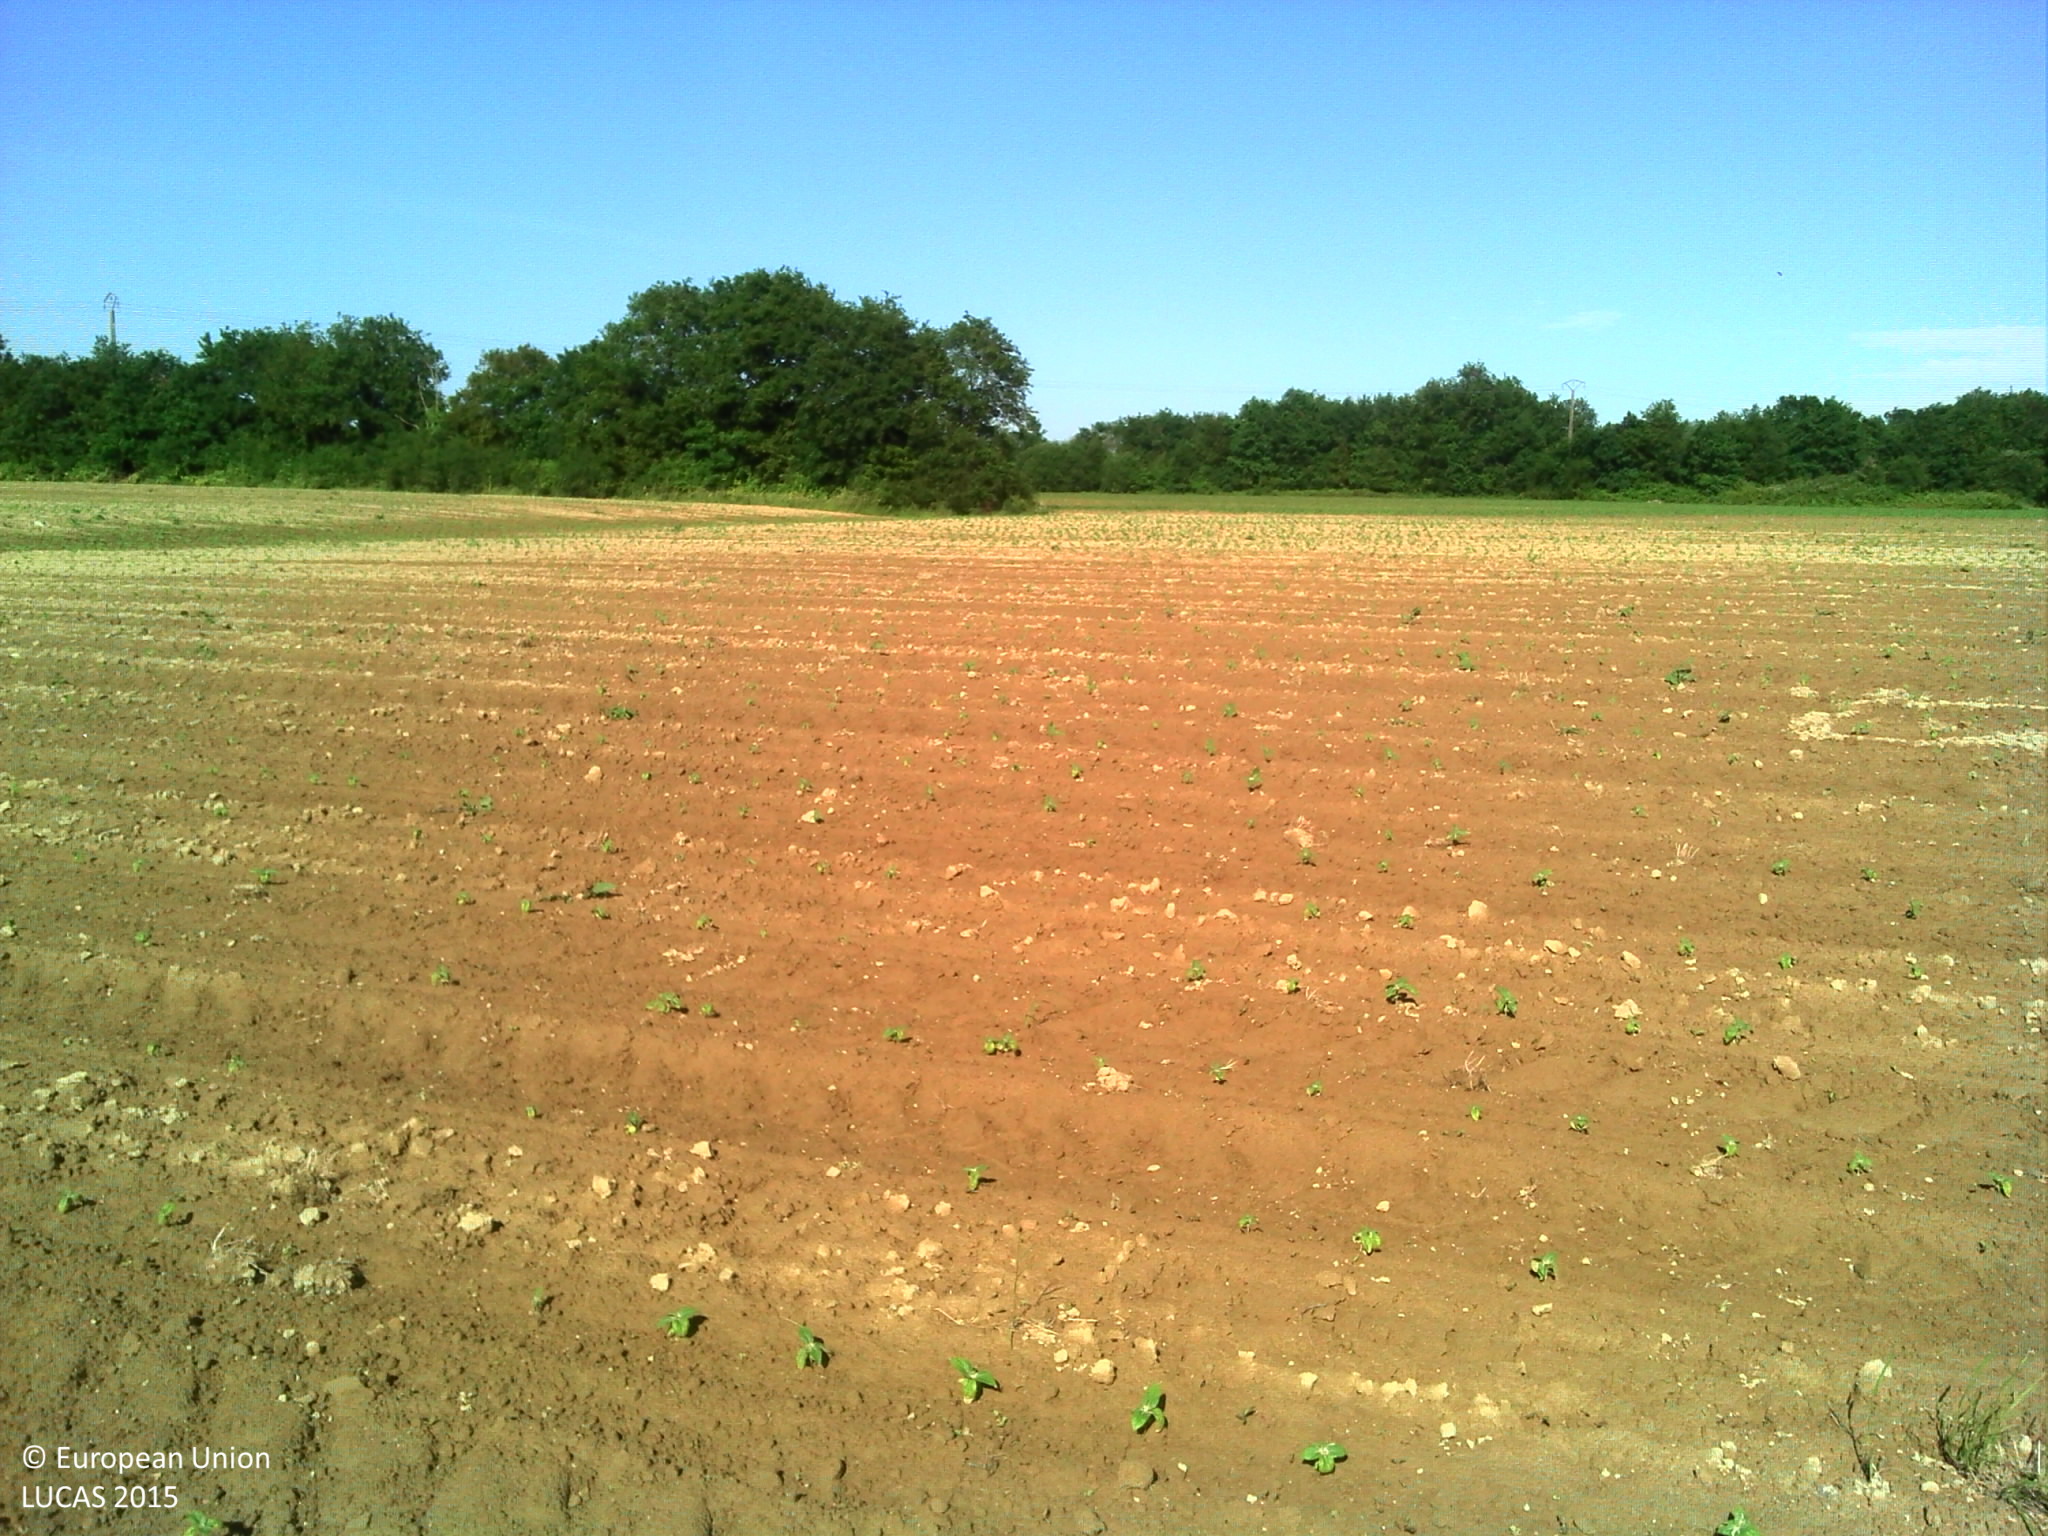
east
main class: Cropland
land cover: Sunflower
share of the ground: < 10 %
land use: Agriculture (excluding fallow land and kitchen gardens)
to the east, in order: Sunflower; Maize; Electric lines; Lines of trees; Ditches and canals; Paved roads, cycling and walking lanes; Ditches and canals; Lines of trees; Common wheat
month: June
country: FR
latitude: 46.8066
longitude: -1.4524
